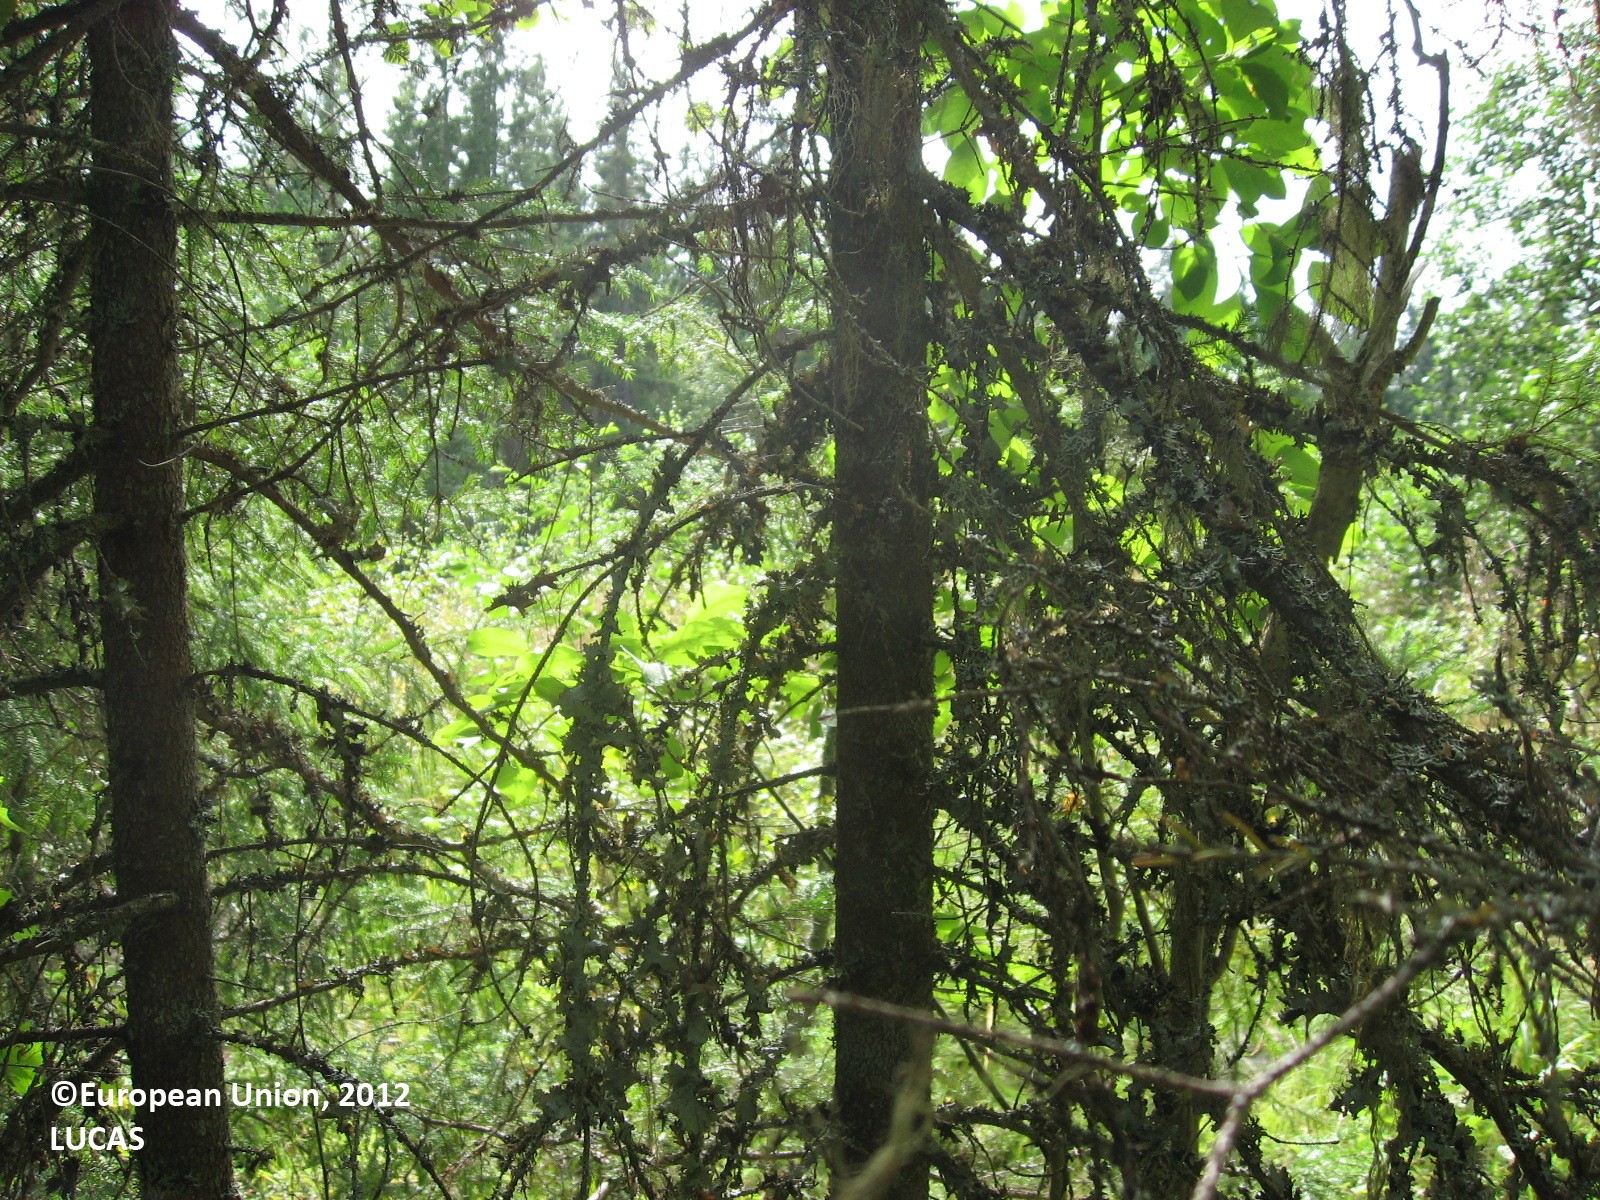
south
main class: Woodland
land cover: Spruce dominated mixed woodland
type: boreal forest
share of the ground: > 75 %
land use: Forestry
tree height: > 5 m
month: August
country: FI
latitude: 61.3323
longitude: 24.8892
